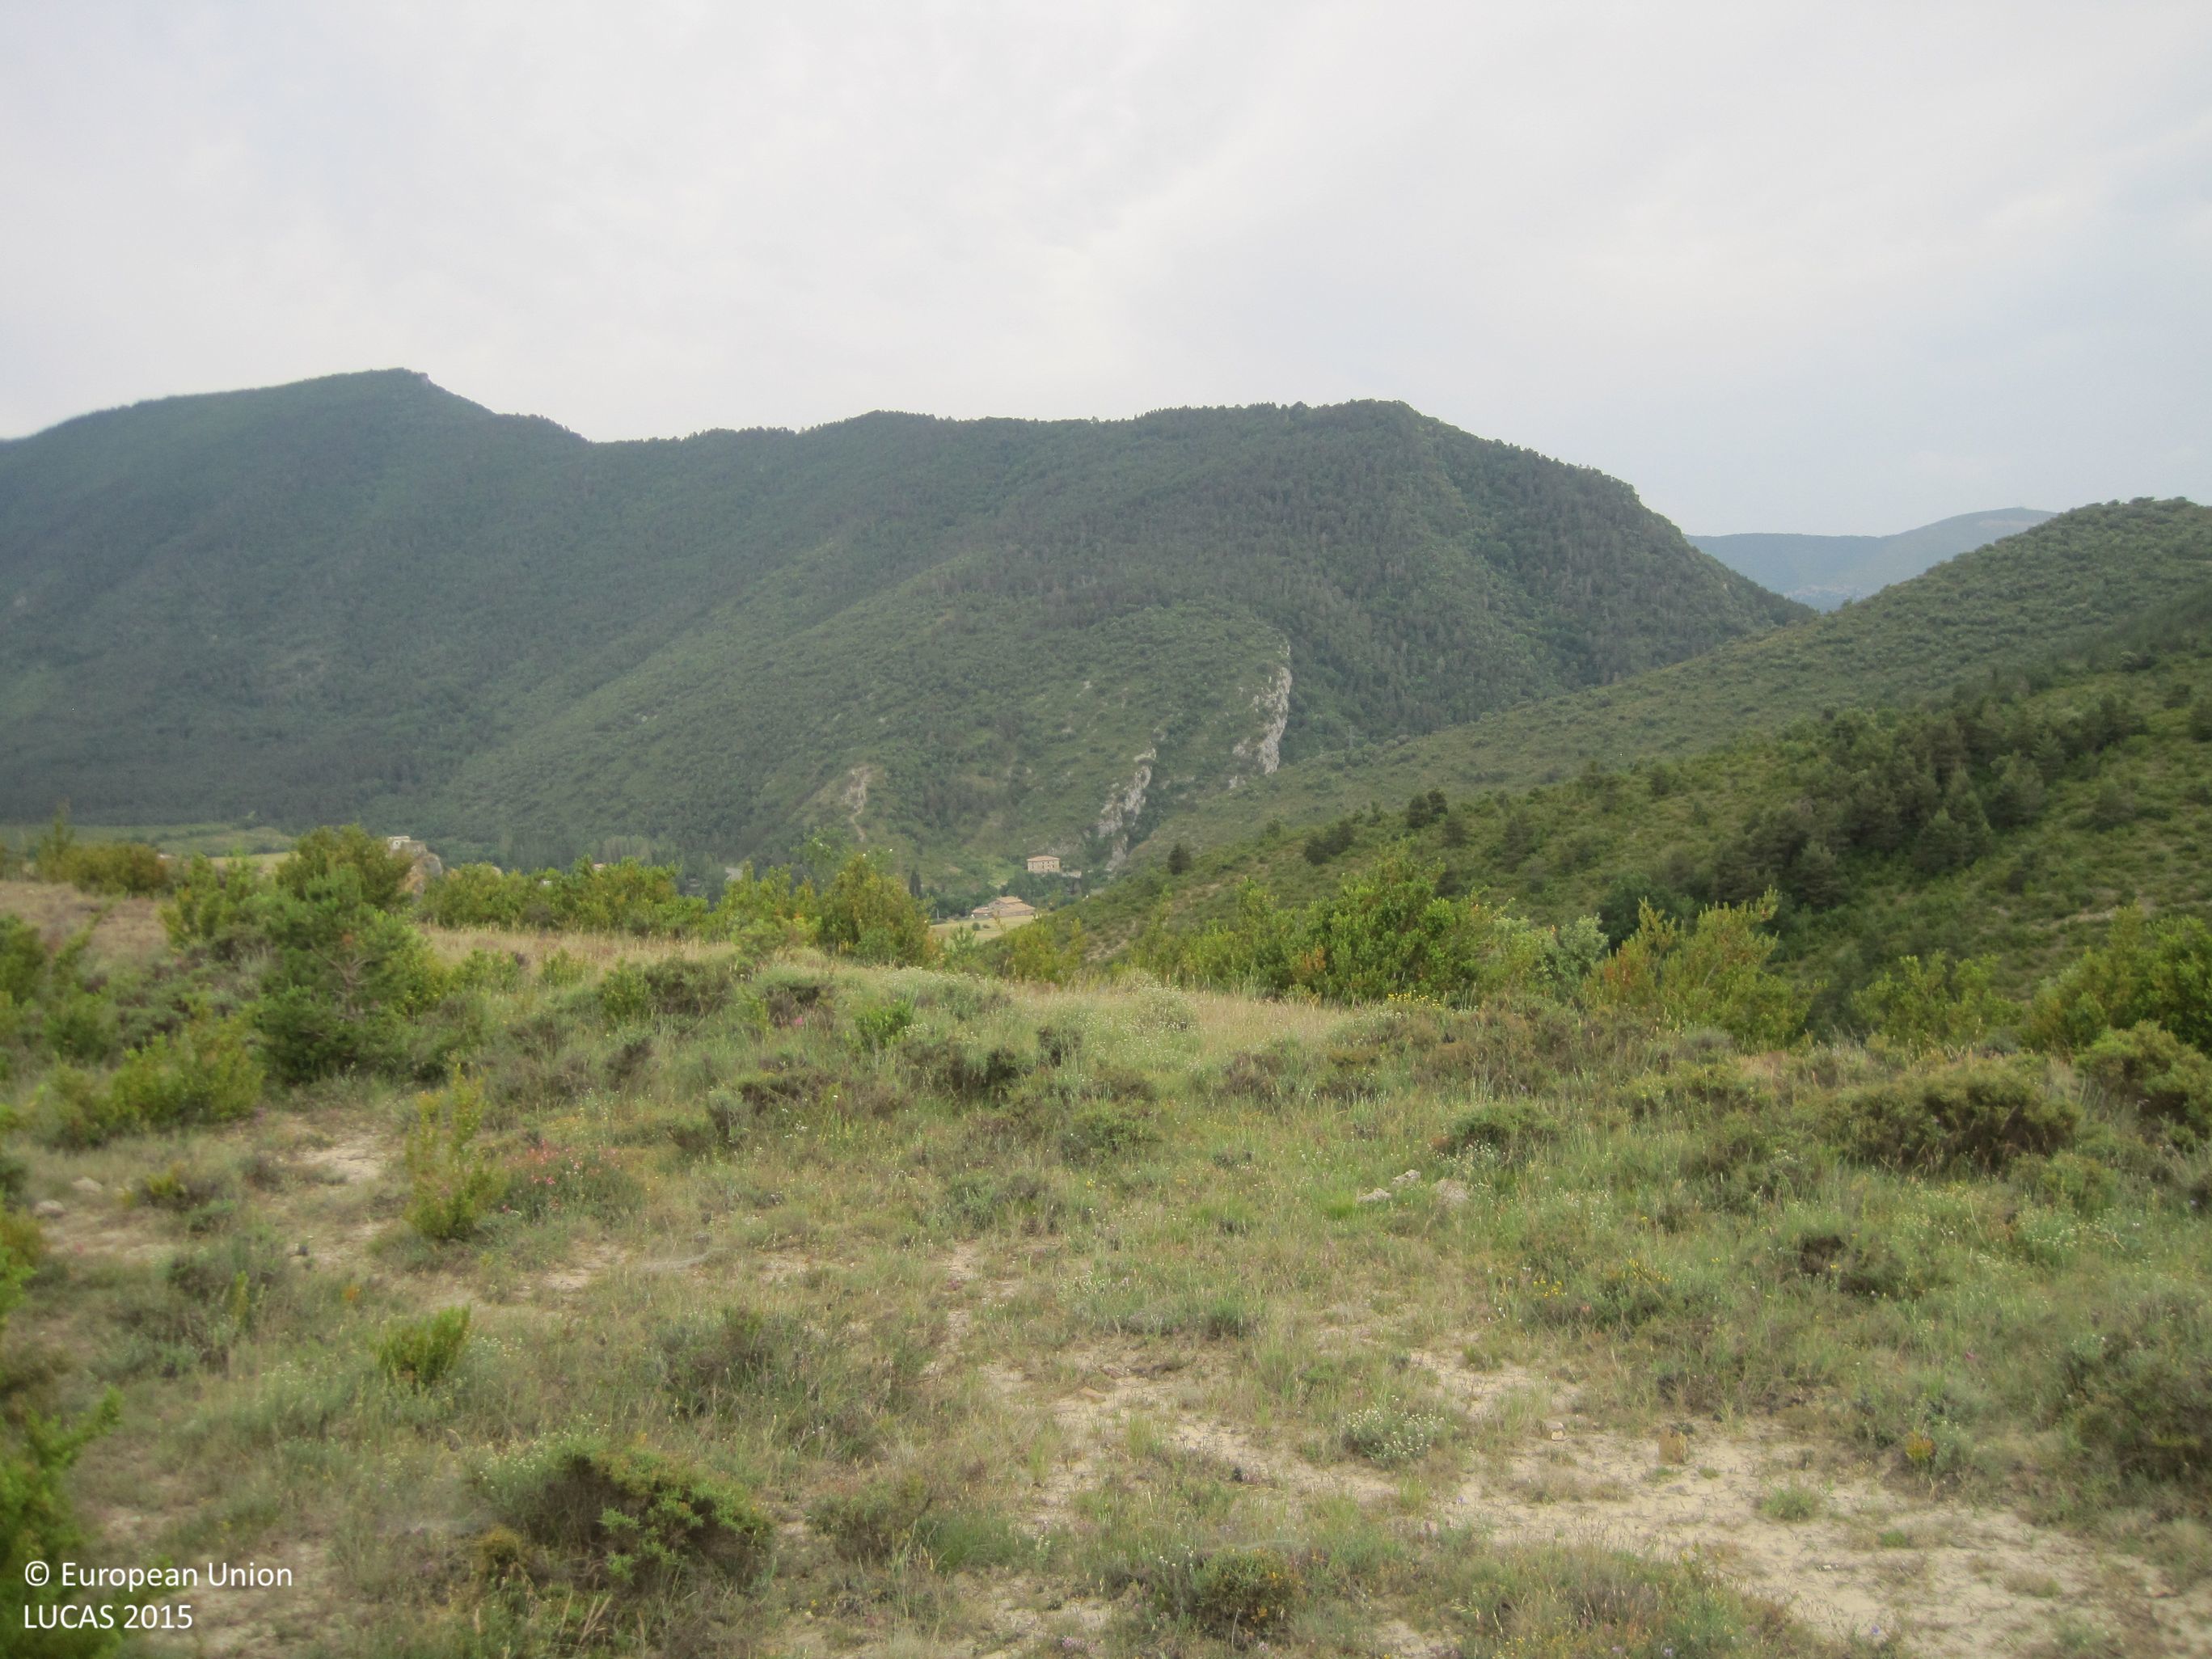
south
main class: Shrubland
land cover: Shrubland without tree cover
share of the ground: > 75 %
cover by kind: shrubs 40 %, herbaceous plants 30 %, consolidated bare surface 30 %
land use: Semi-natural and natural areas not in use
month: June
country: ES
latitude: 42.7274
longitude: -1.1595
